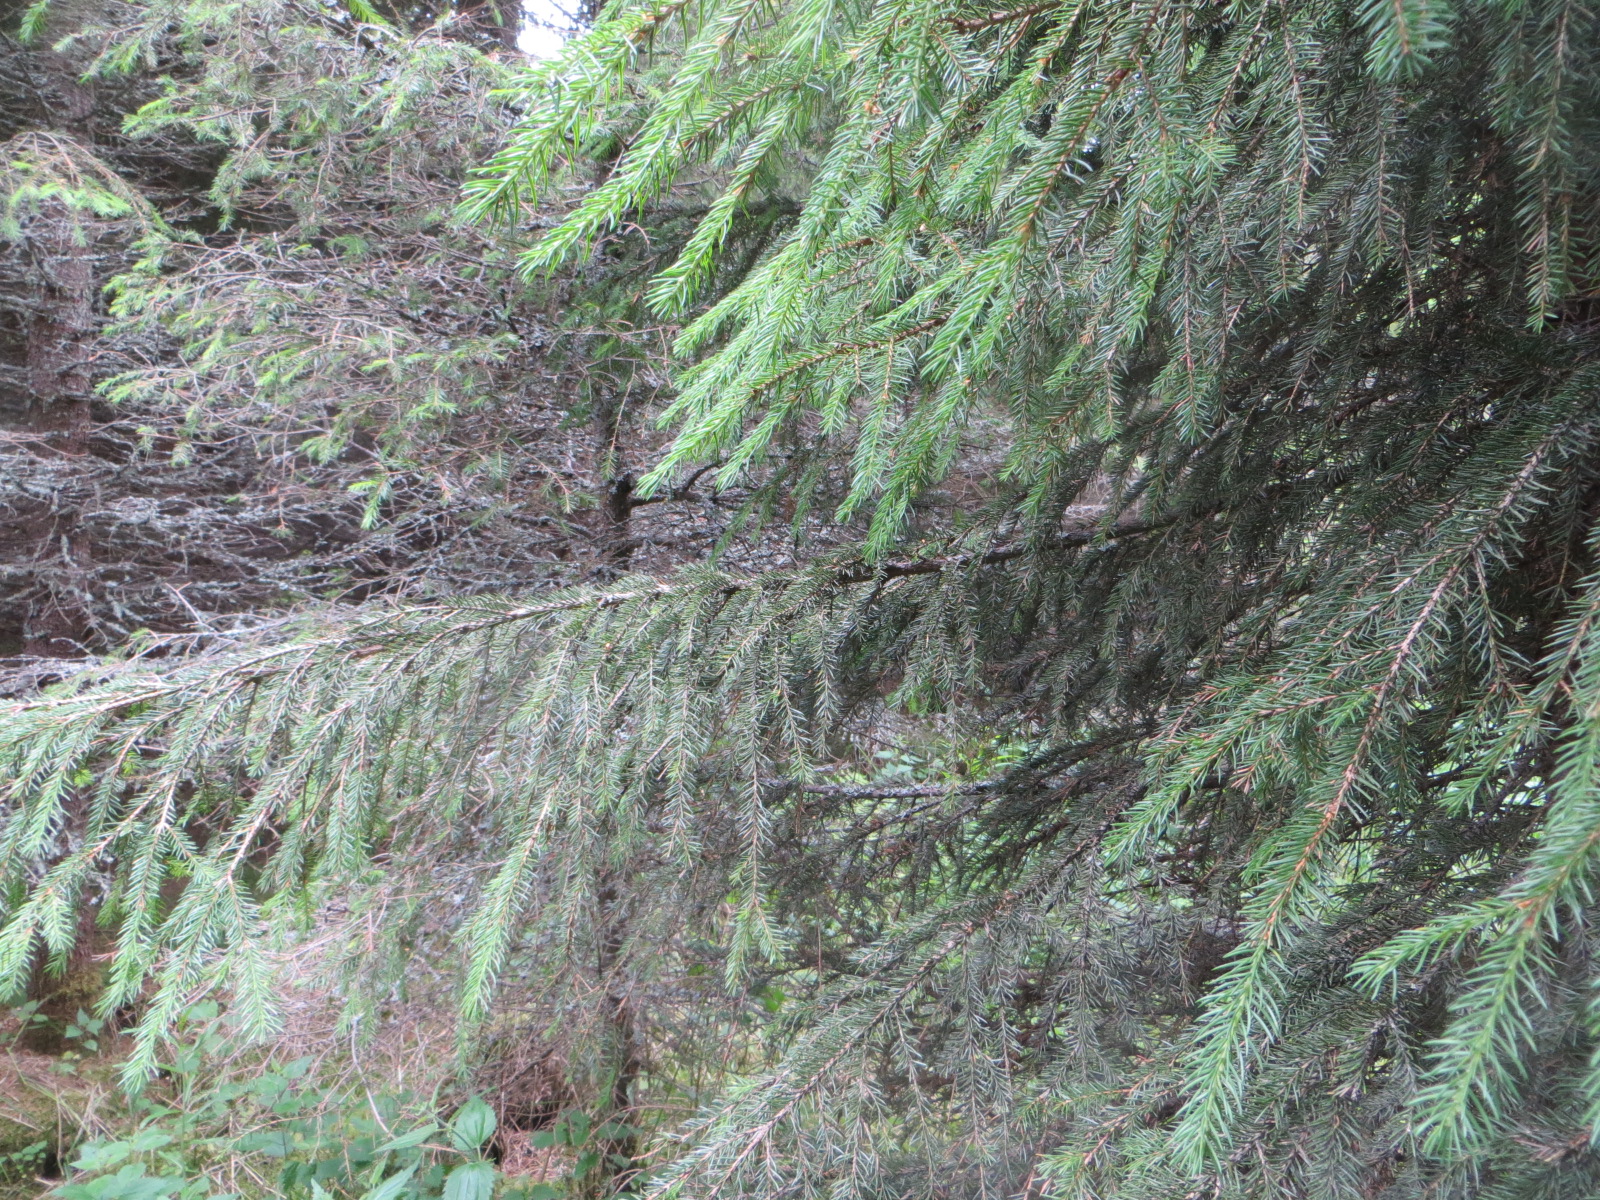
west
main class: Woodland
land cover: Spruce dominated coniferous woodland
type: boreal forest
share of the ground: > 75 %
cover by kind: coniferous forest trees 90 %, shrubs 10 %
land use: Forestry
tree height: > 5 m
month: July
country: FI
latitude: 65.7769
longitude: 25.2938
